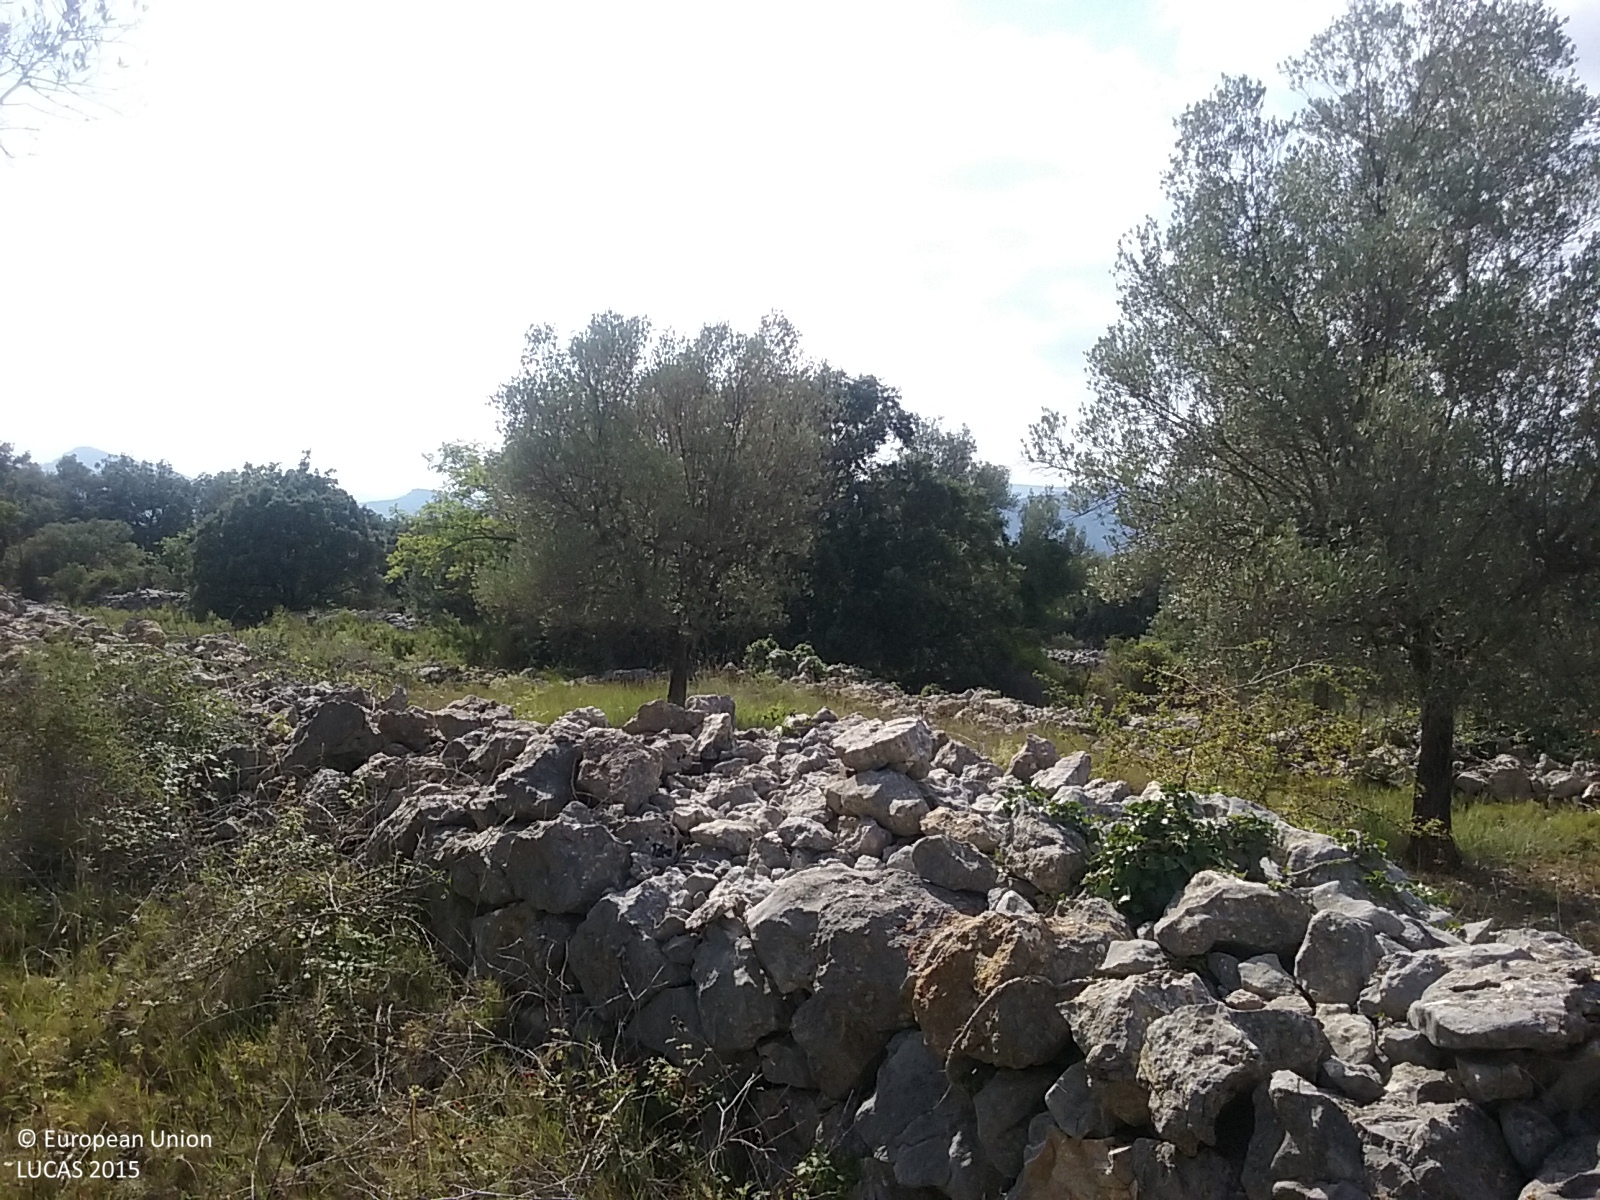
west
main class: Cropland
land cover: Olive groves
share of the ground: 25 - 50 %
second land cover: Spontaneously vegetated surfaces
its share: 25 - 50 %
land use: Agriculture (excluding fallow land and kitchen gardens)
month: August
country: ES
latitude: 40.3383
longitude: 0.0018
